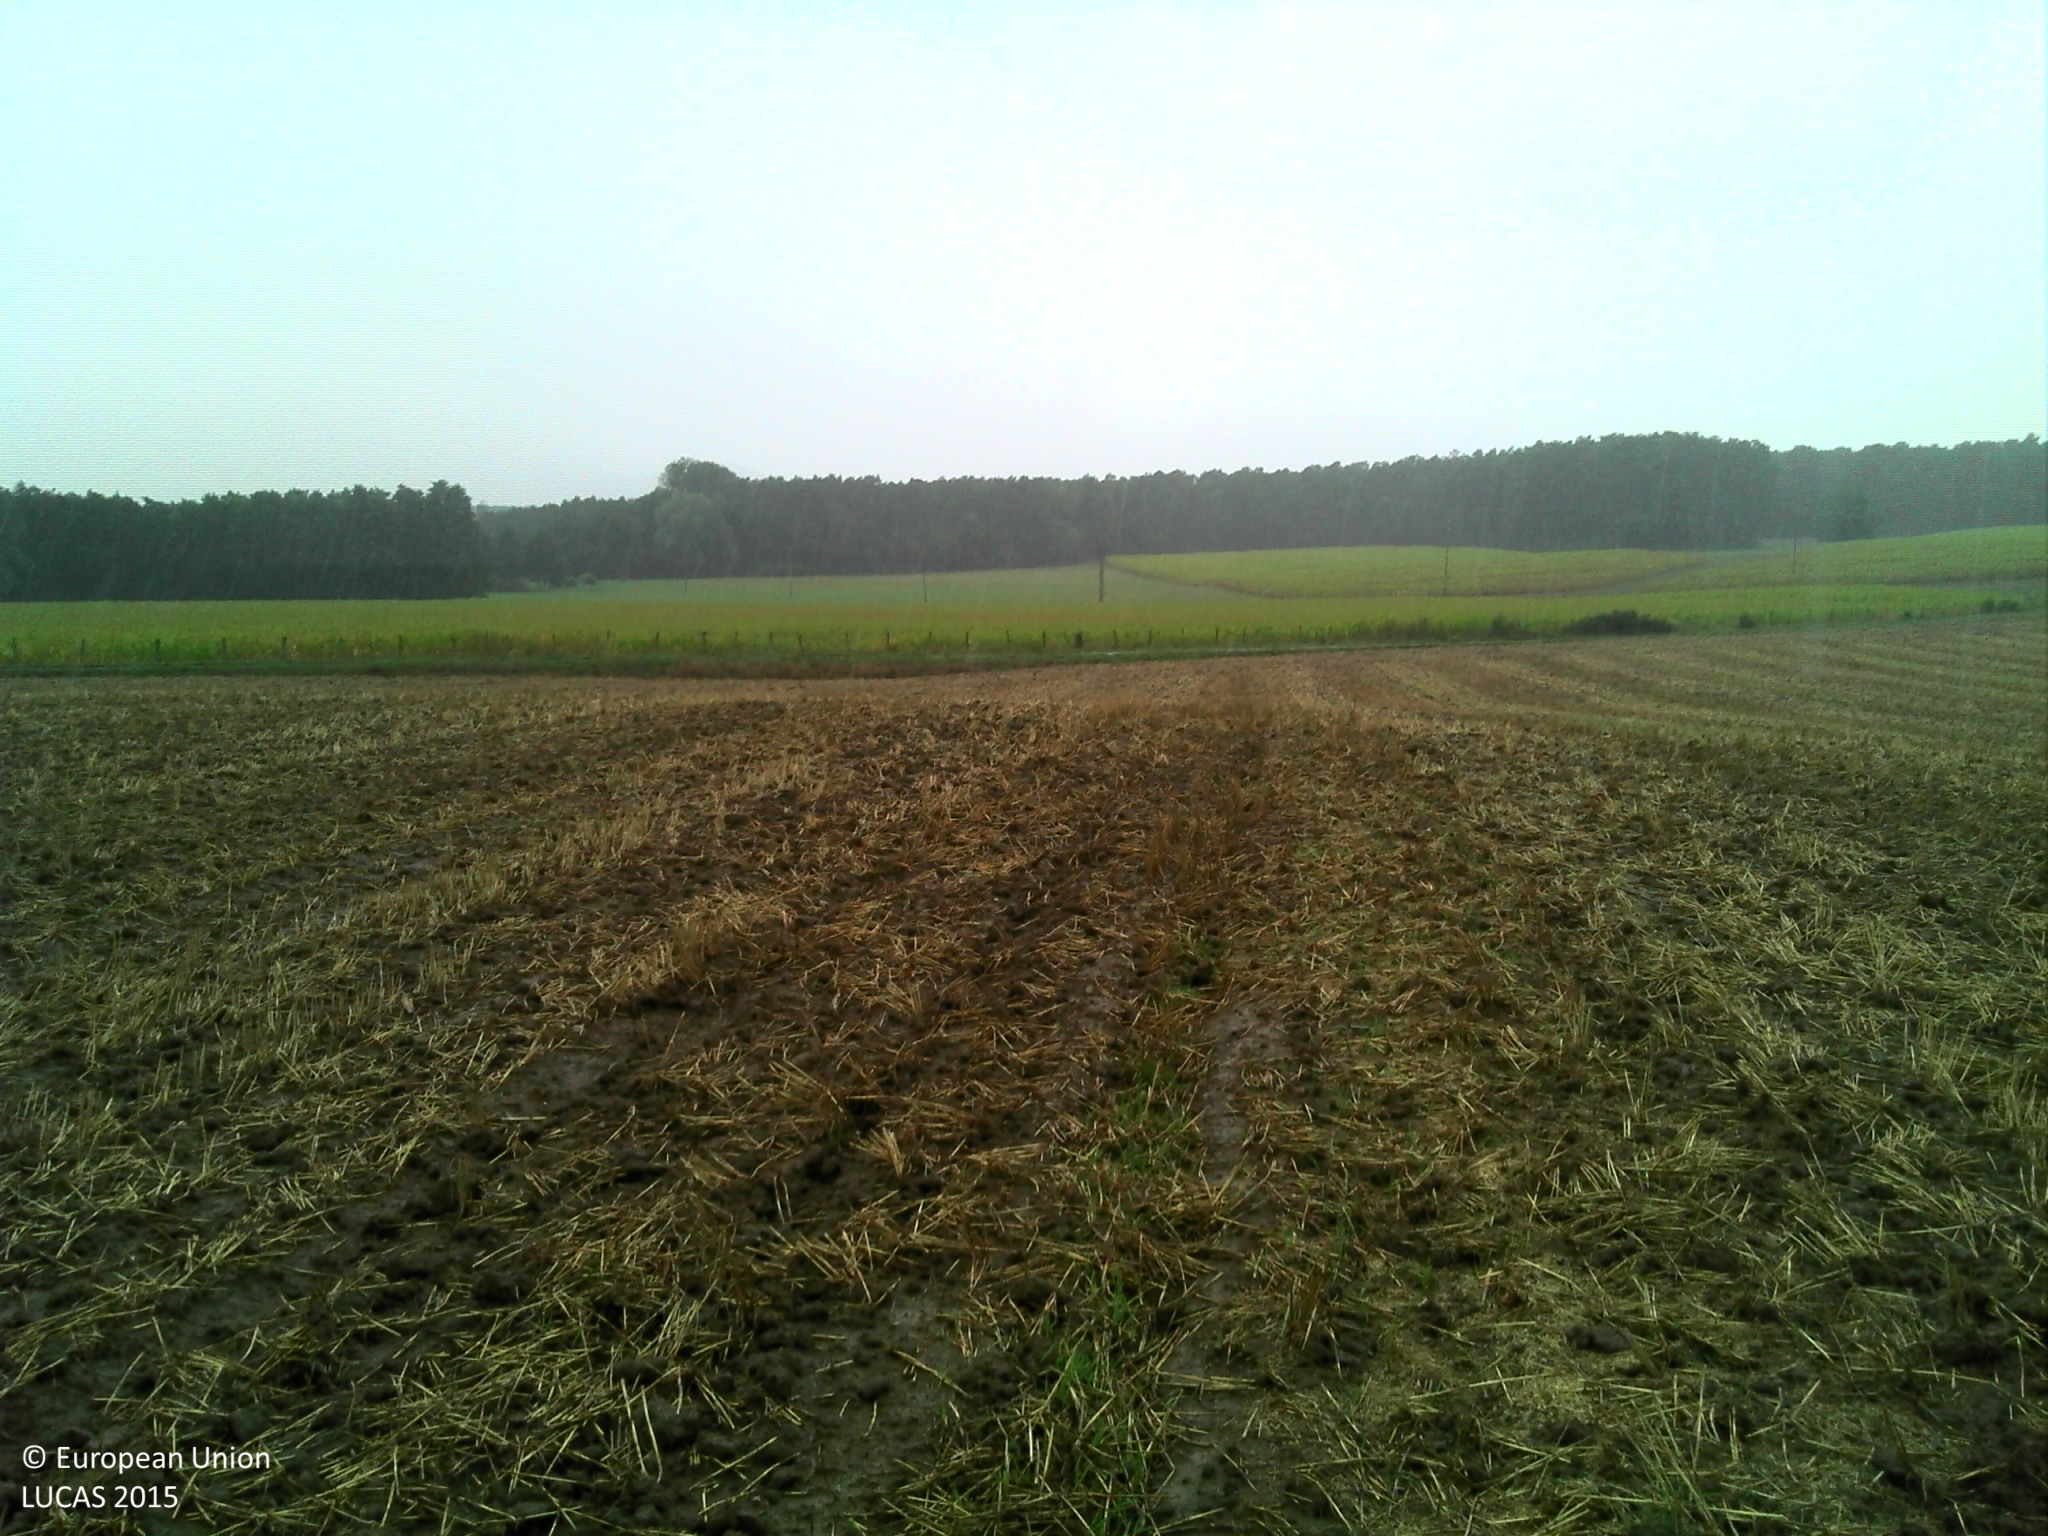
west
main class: Cropland
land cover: Triticale
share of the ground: 10 - 25 %
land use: Agriculture (excluding fallow land and kitchen gardens)
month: August
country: FR
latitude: 48.8422
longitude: 7.4526
